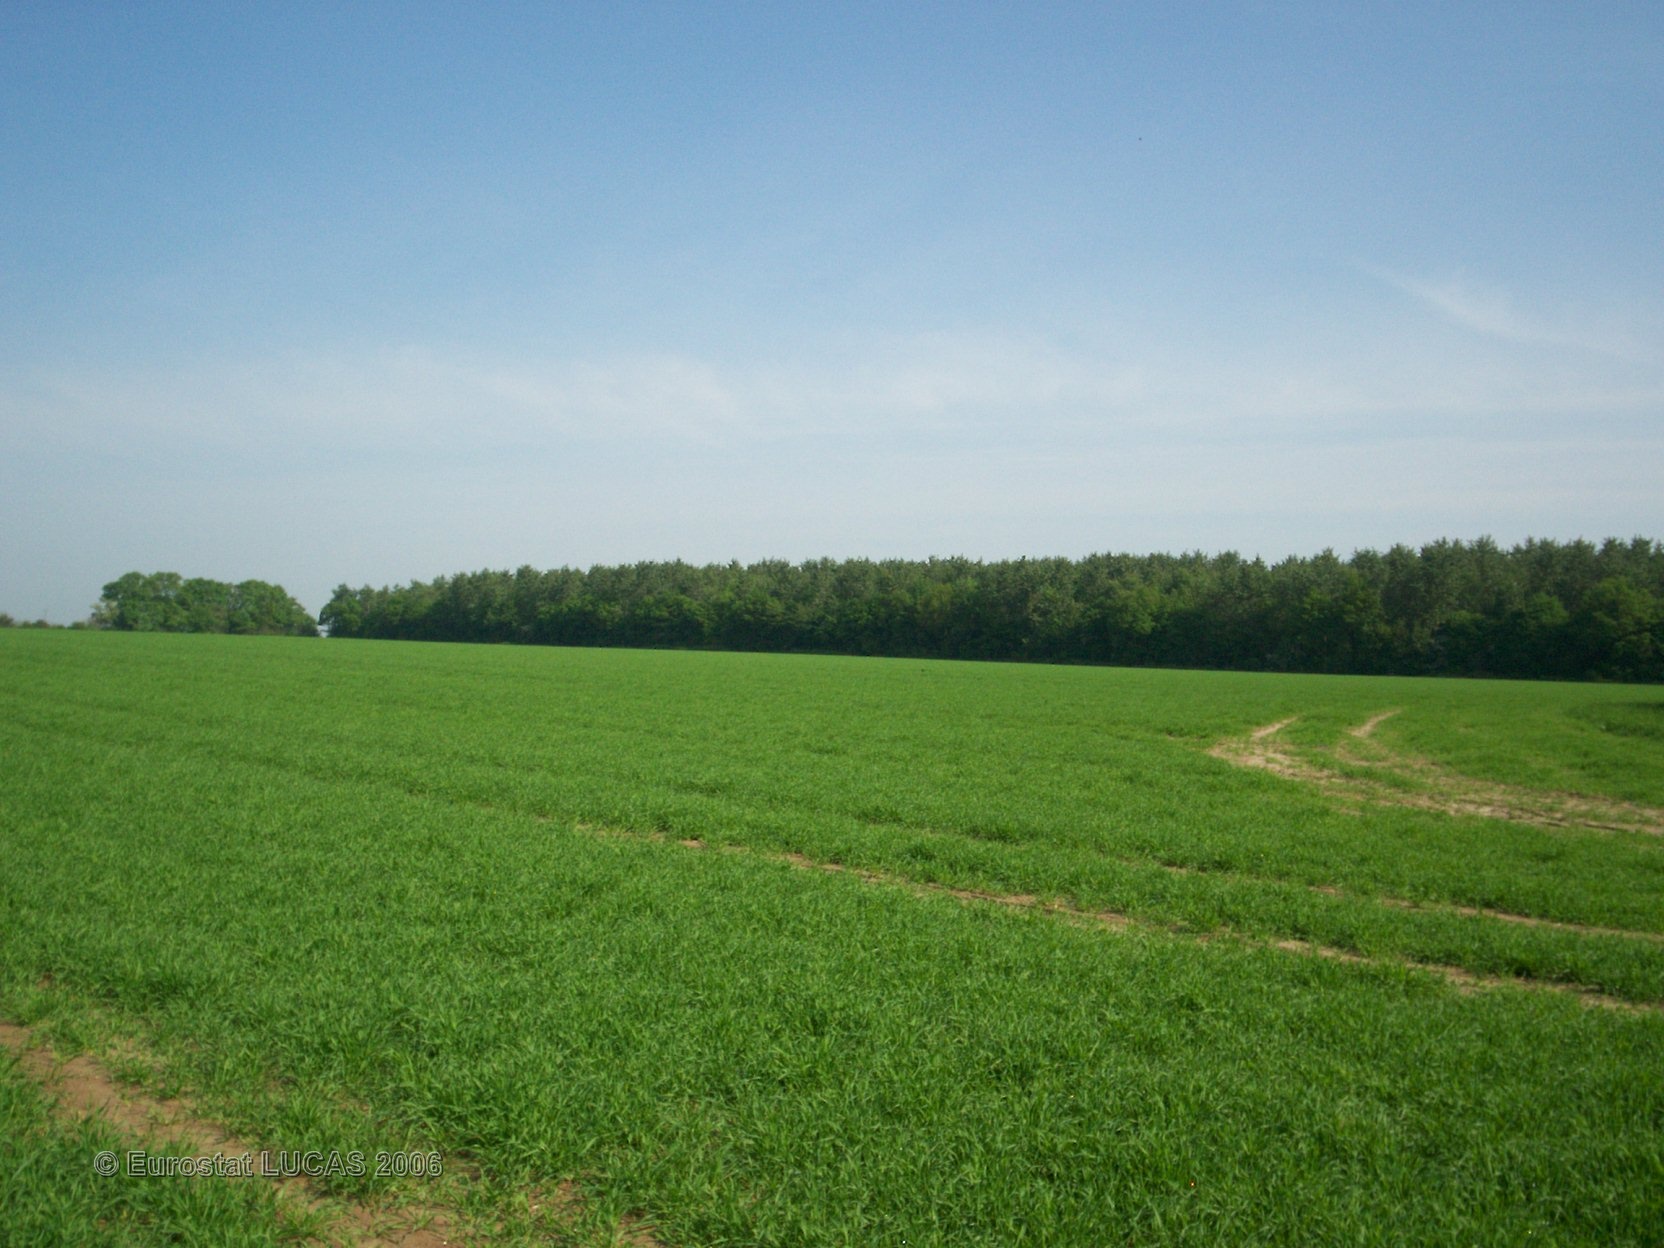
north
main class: Cropland
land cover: Barley
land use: Agriculture (excluding fallow land and kitchen gardens)
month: May
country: FR
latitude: 49.0523
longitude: 2.7789
